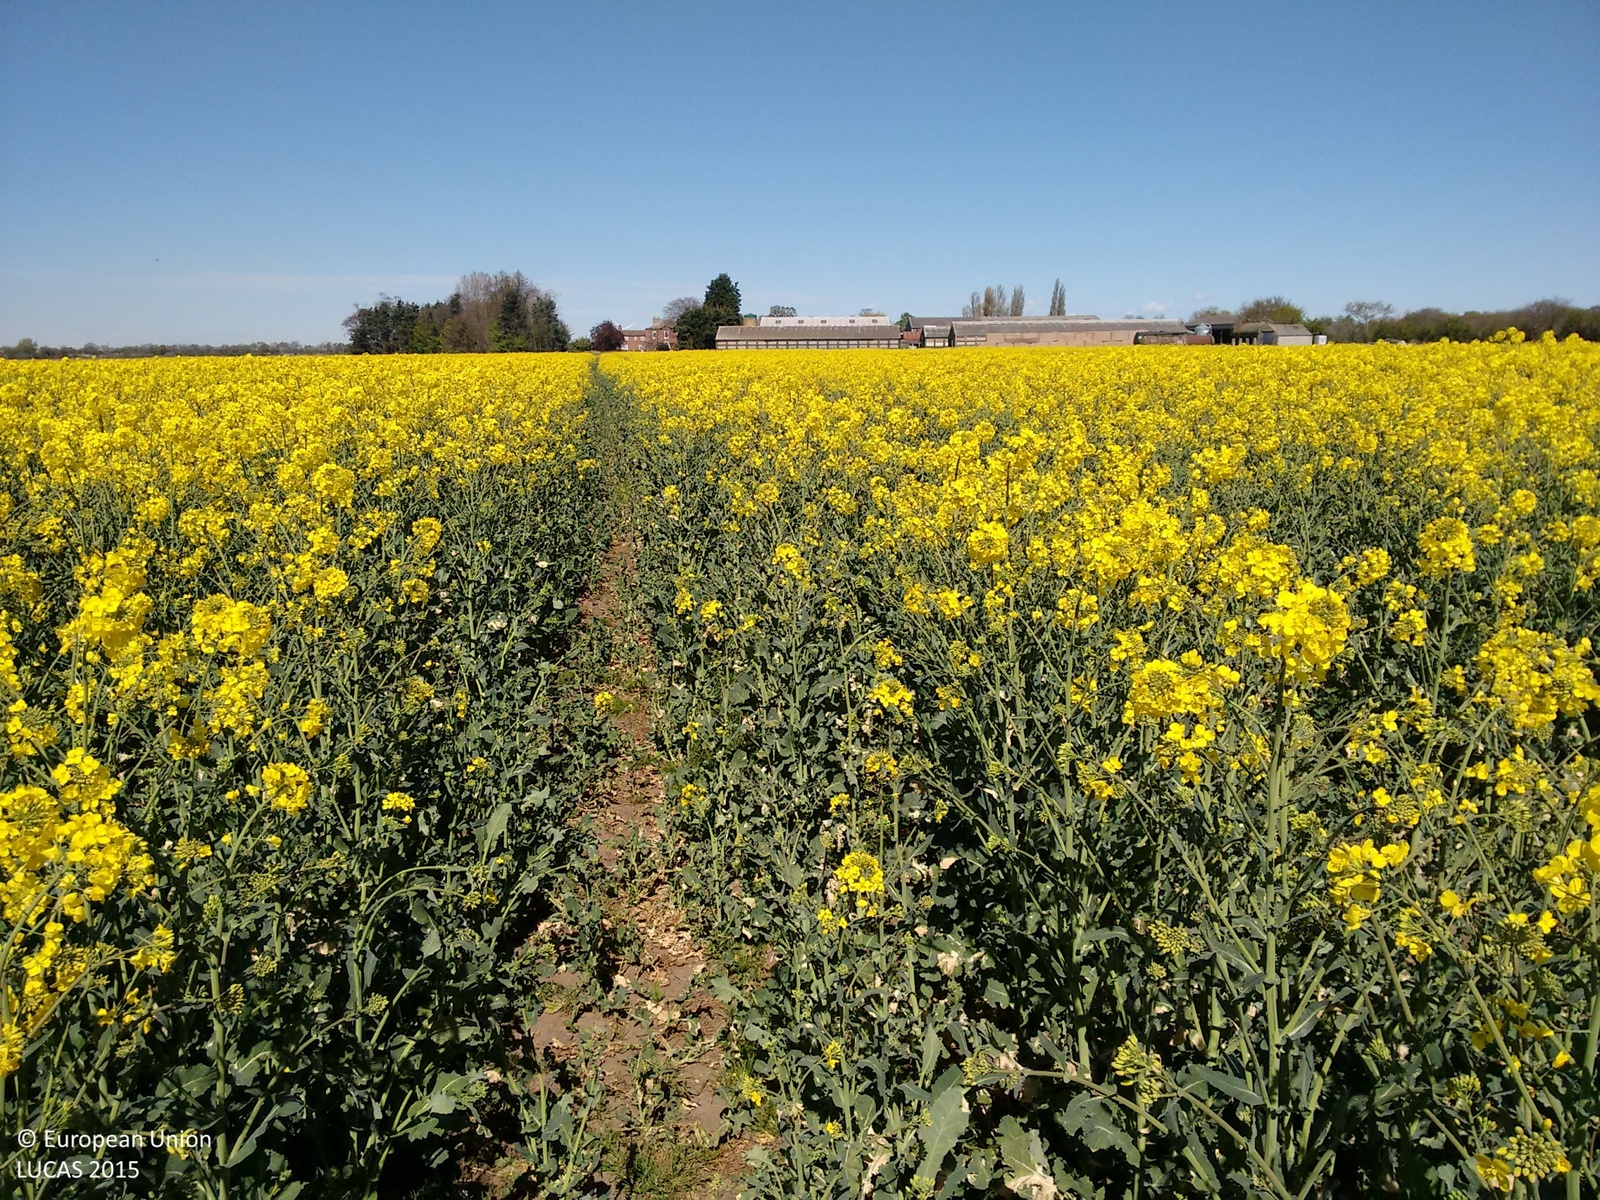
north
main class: Cropland
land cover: Rape and turnip rape
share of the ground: > 75 %
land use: Agriculture (excluding fallow land and kitchen gardens)
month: April
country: GB
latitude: 53.8237
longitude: -0.8113
